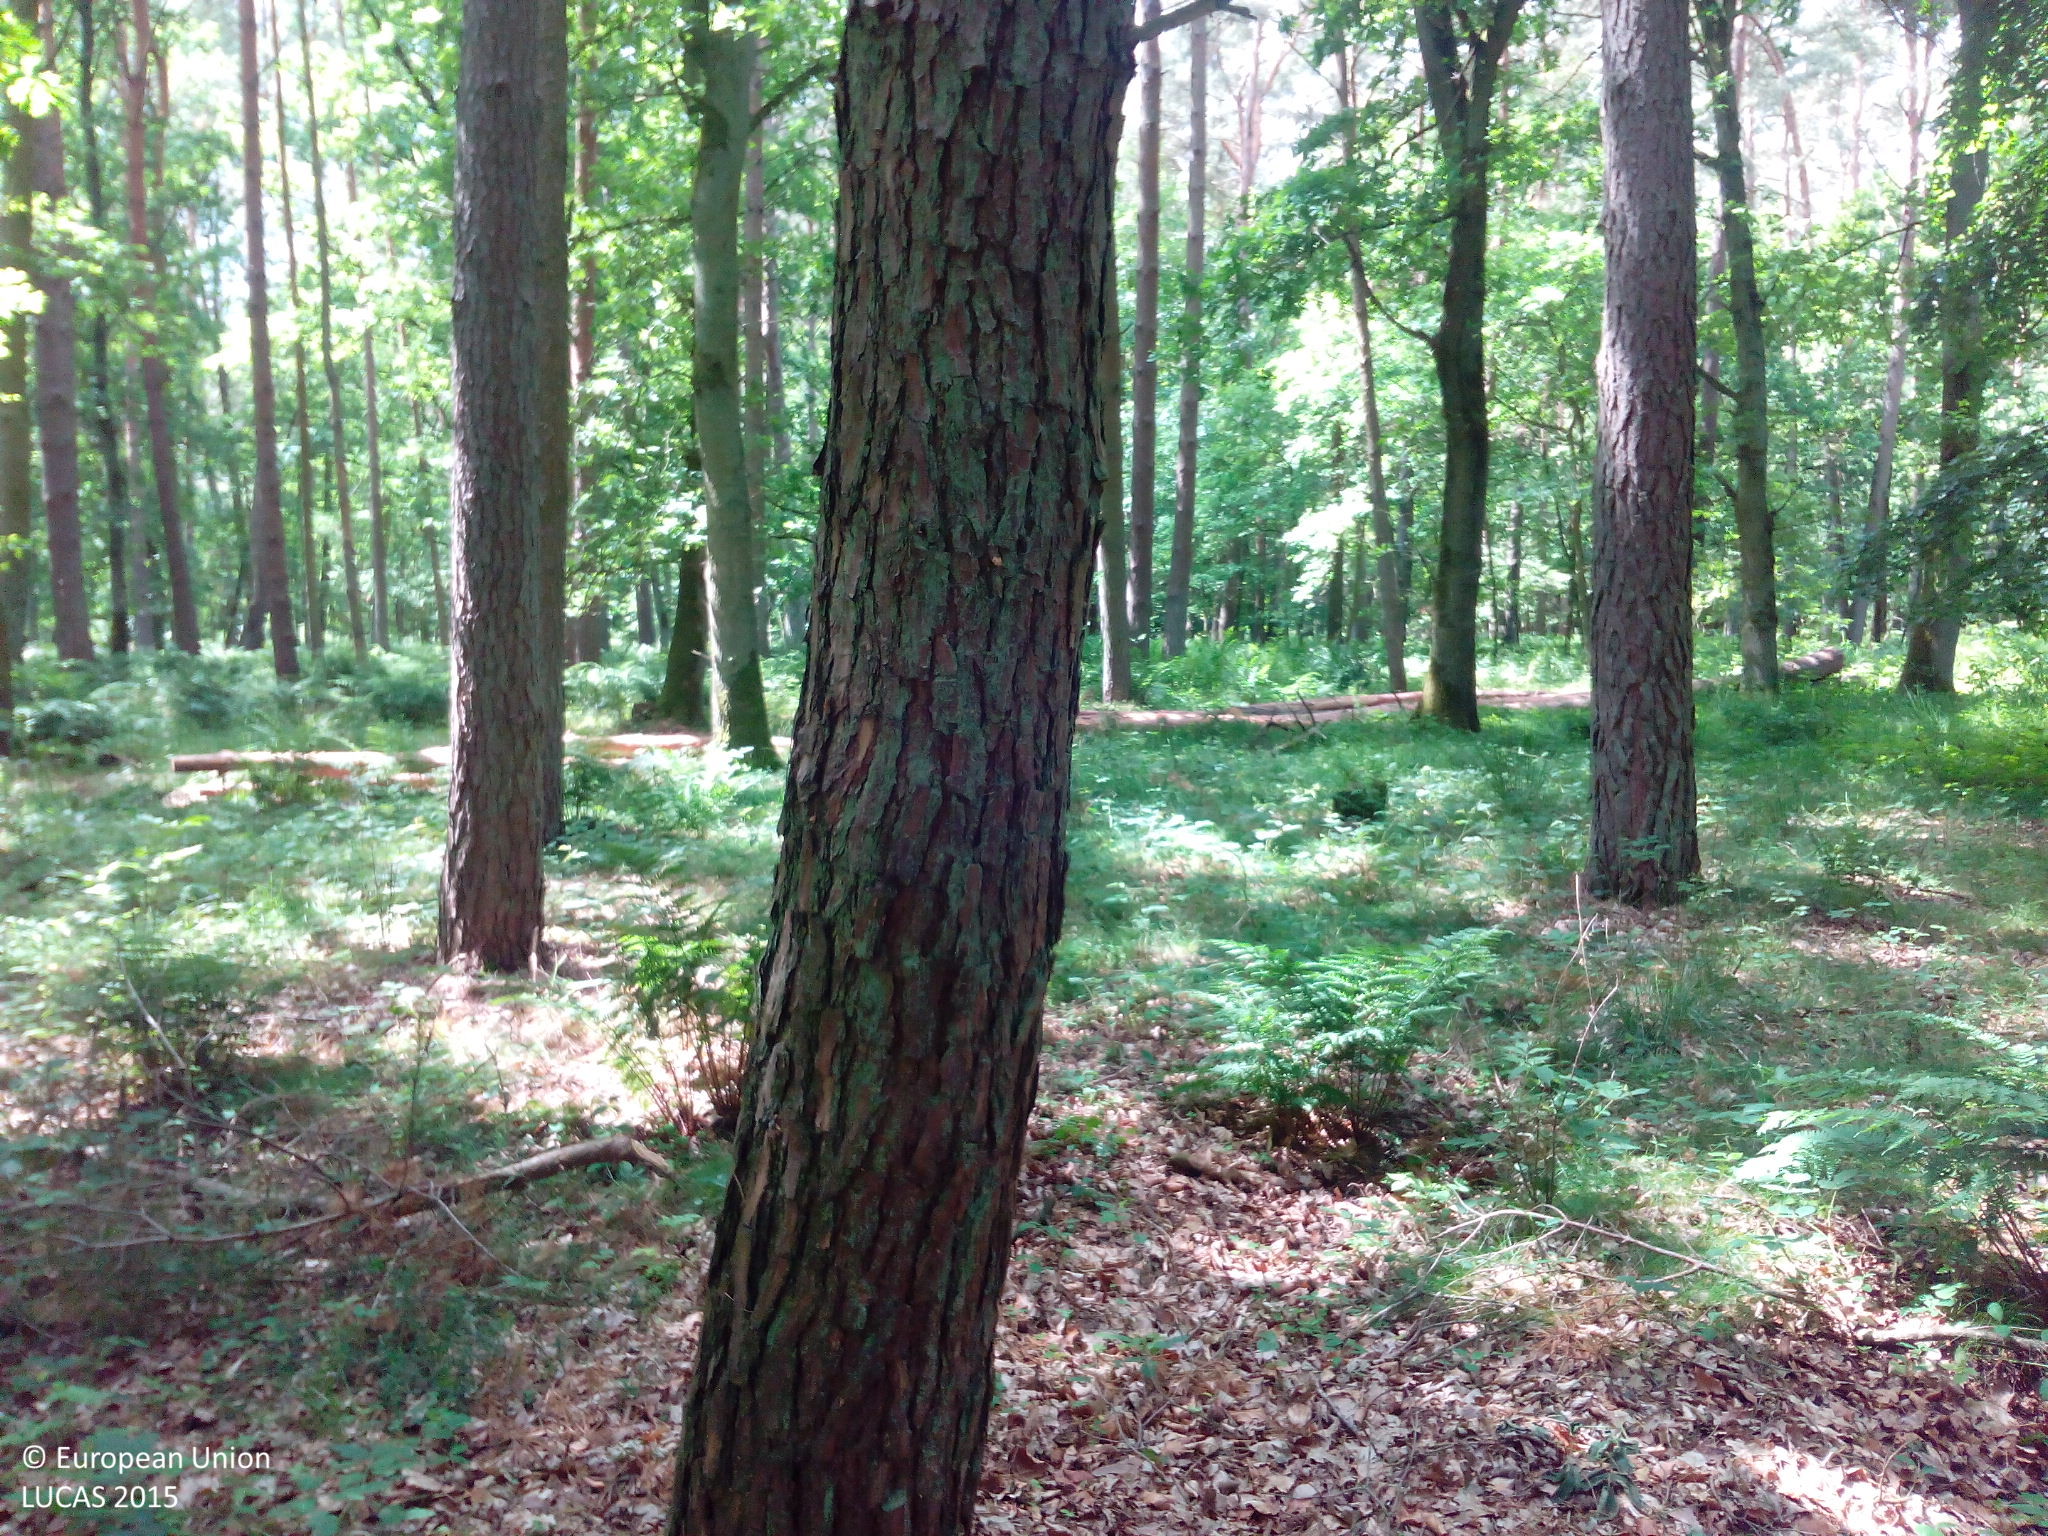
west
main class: Woodland
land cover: Pine dominated mixed woodland
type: hemiboreal forest and nemoral coniferous forest and mixed broadleaved-coniferous forest
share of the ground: > 75 %
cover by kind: coniferous forest trees 50 %, broadleaved forest trees 30 %, unconsolidated bare surface 10 %, shrubs 5 %, herbaceous plants 5 %
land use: Forestry
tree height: > 5 m
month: June
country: DE
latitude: 53.8459
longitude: 11.1394
